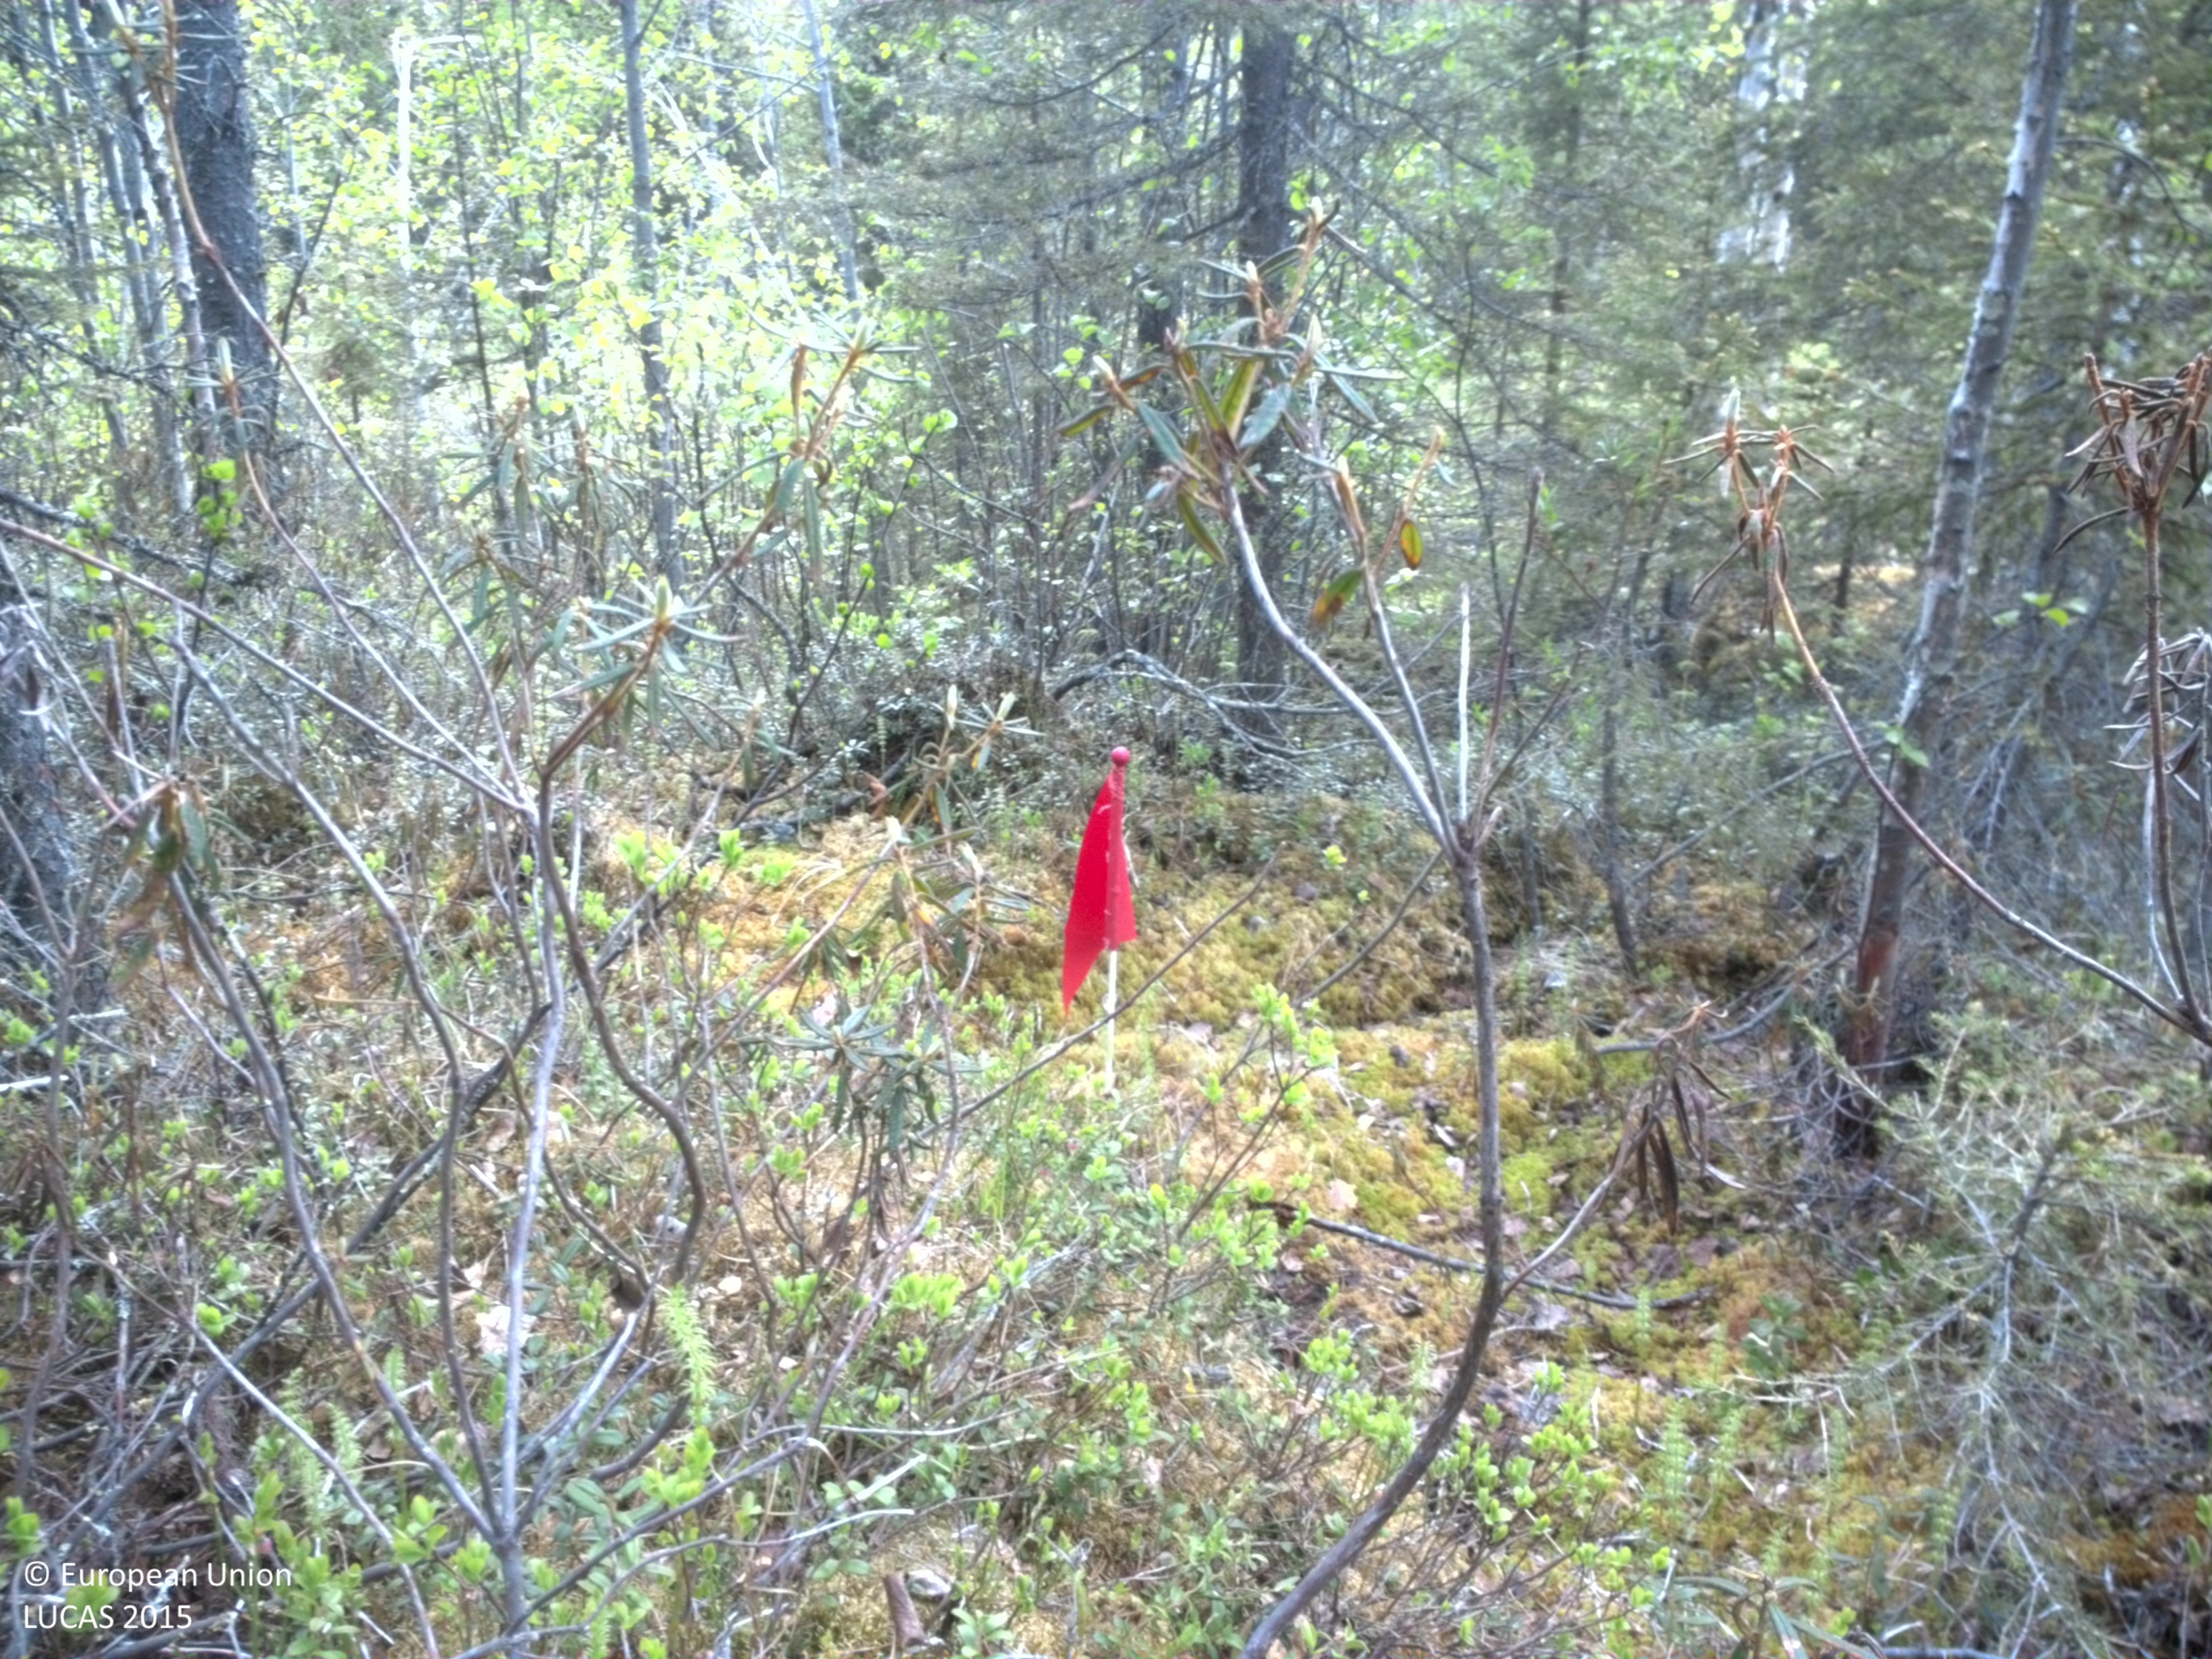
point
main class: Woodland
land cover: Other mixed woodland
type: boreal forest
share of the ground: 50 - 75 %
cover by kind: coniferous forest trees 35 %, shrubs 30 %, broadleaved forest trees 15 %, herbaceous plants 15 %, lichens and mosses 5 %
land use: Forestry
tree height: > 5 m
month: June
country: SE
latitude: 66.7515
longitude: 21.9274
